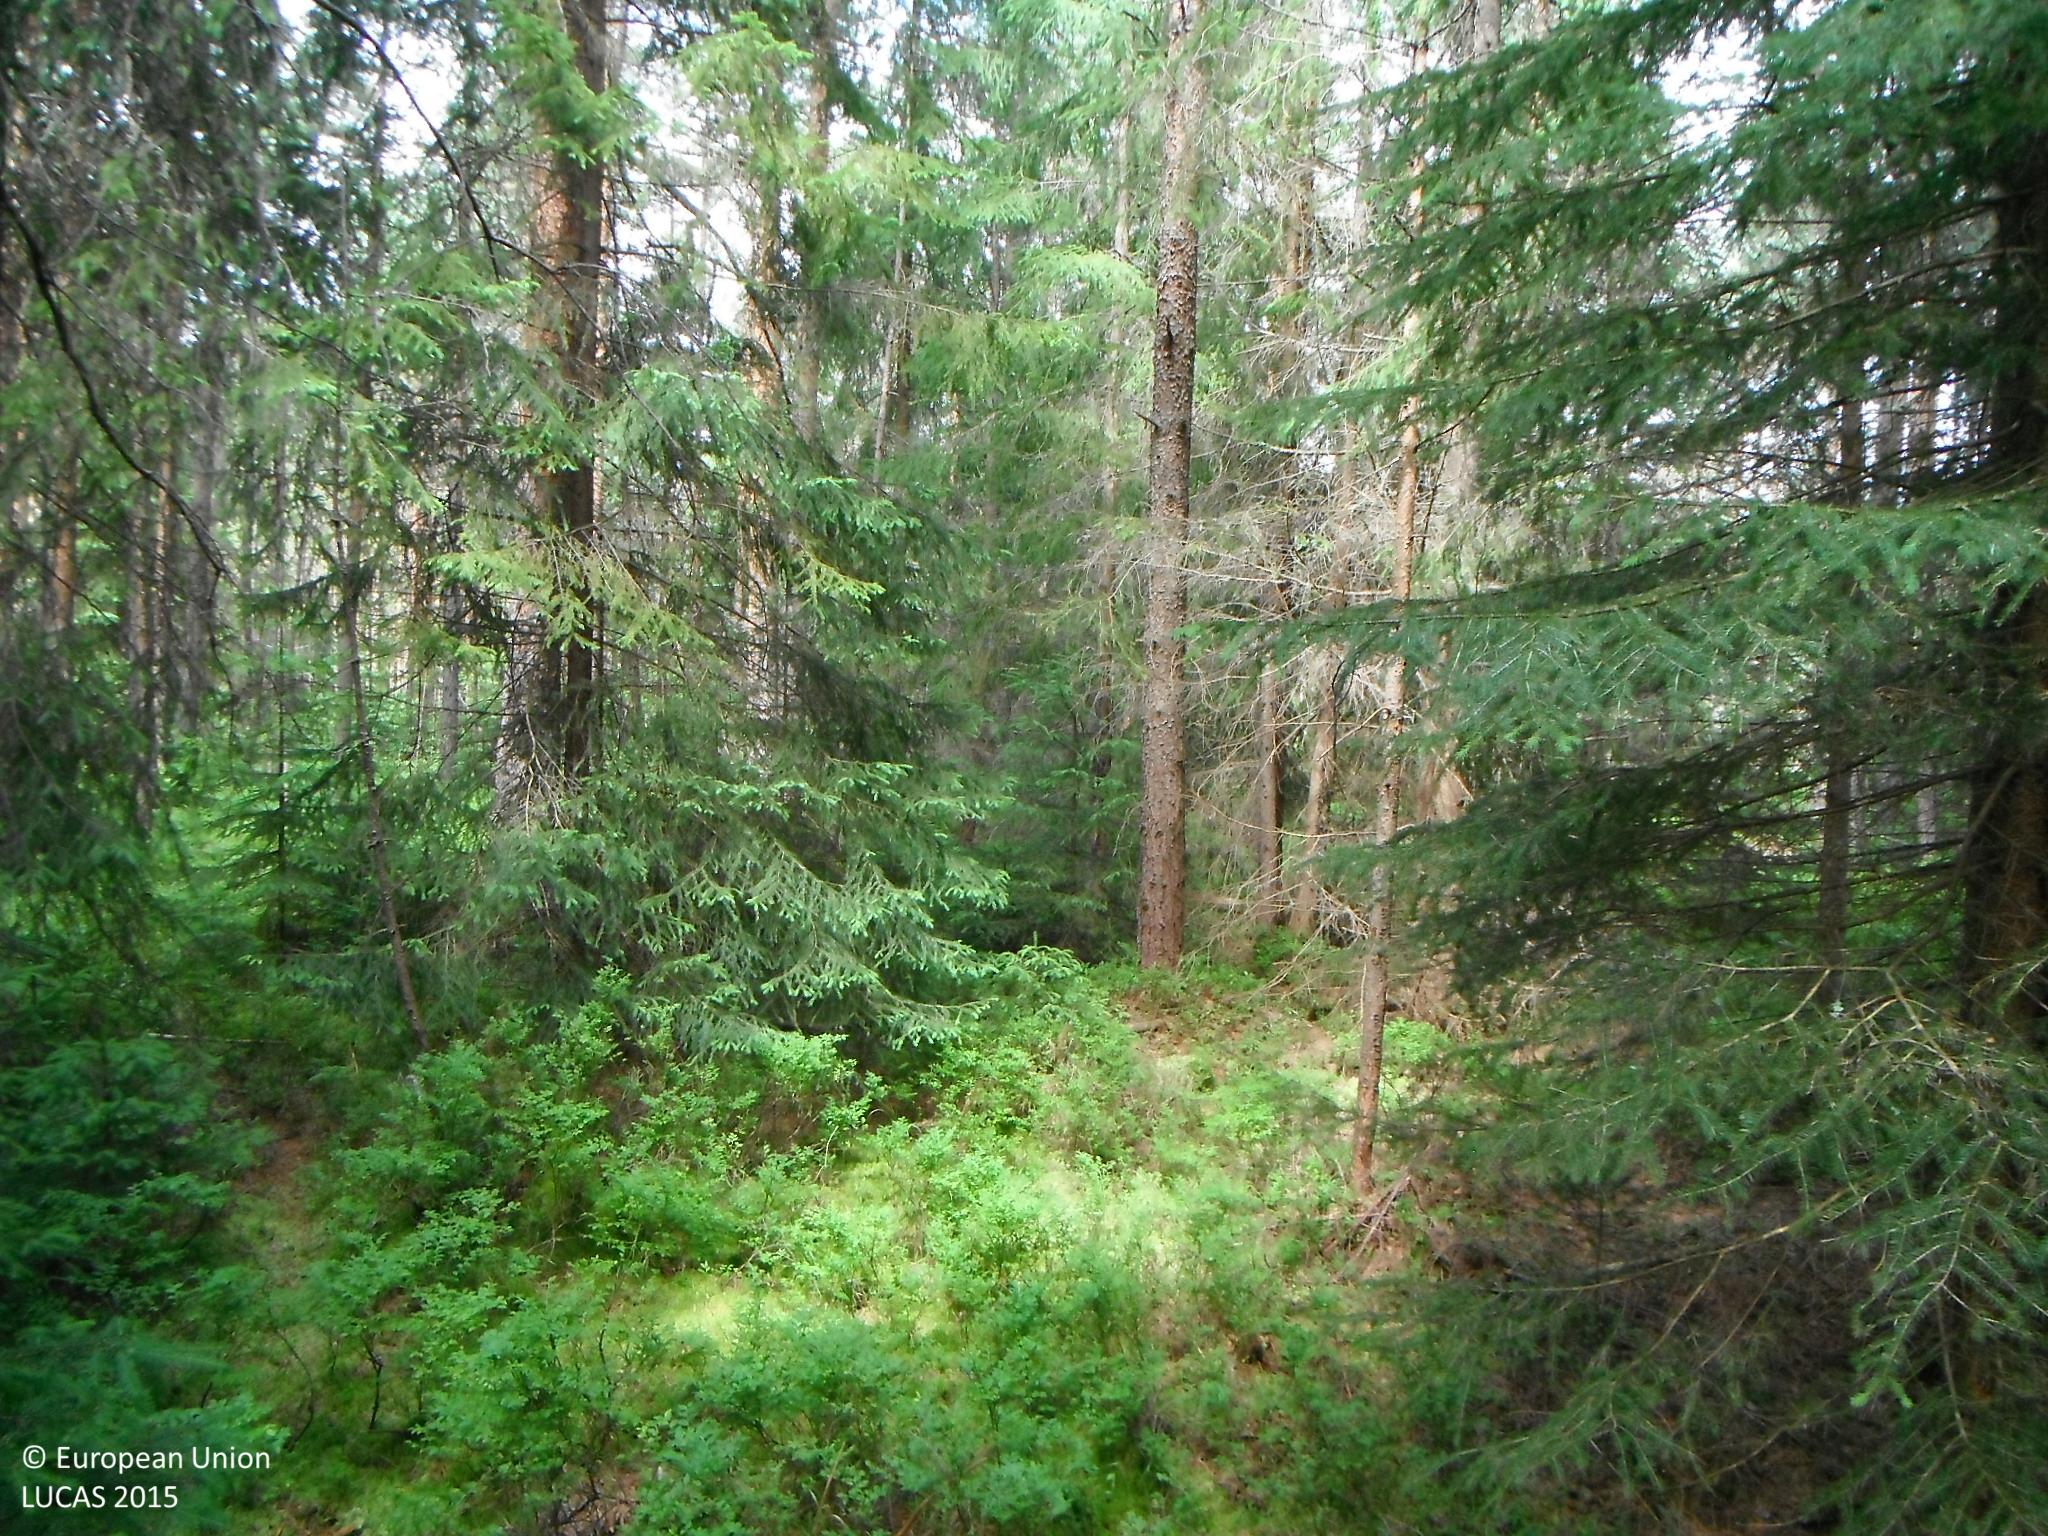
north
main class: Woodland
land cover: Spruce dominated coniferous woodland
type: alpine coniferous forest
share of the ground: > 75 %
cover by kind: coniferous forest trees 100 %
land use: Forestry
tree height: > 5 m
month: July
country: SK
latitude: 49.4012
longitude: 19.7717
